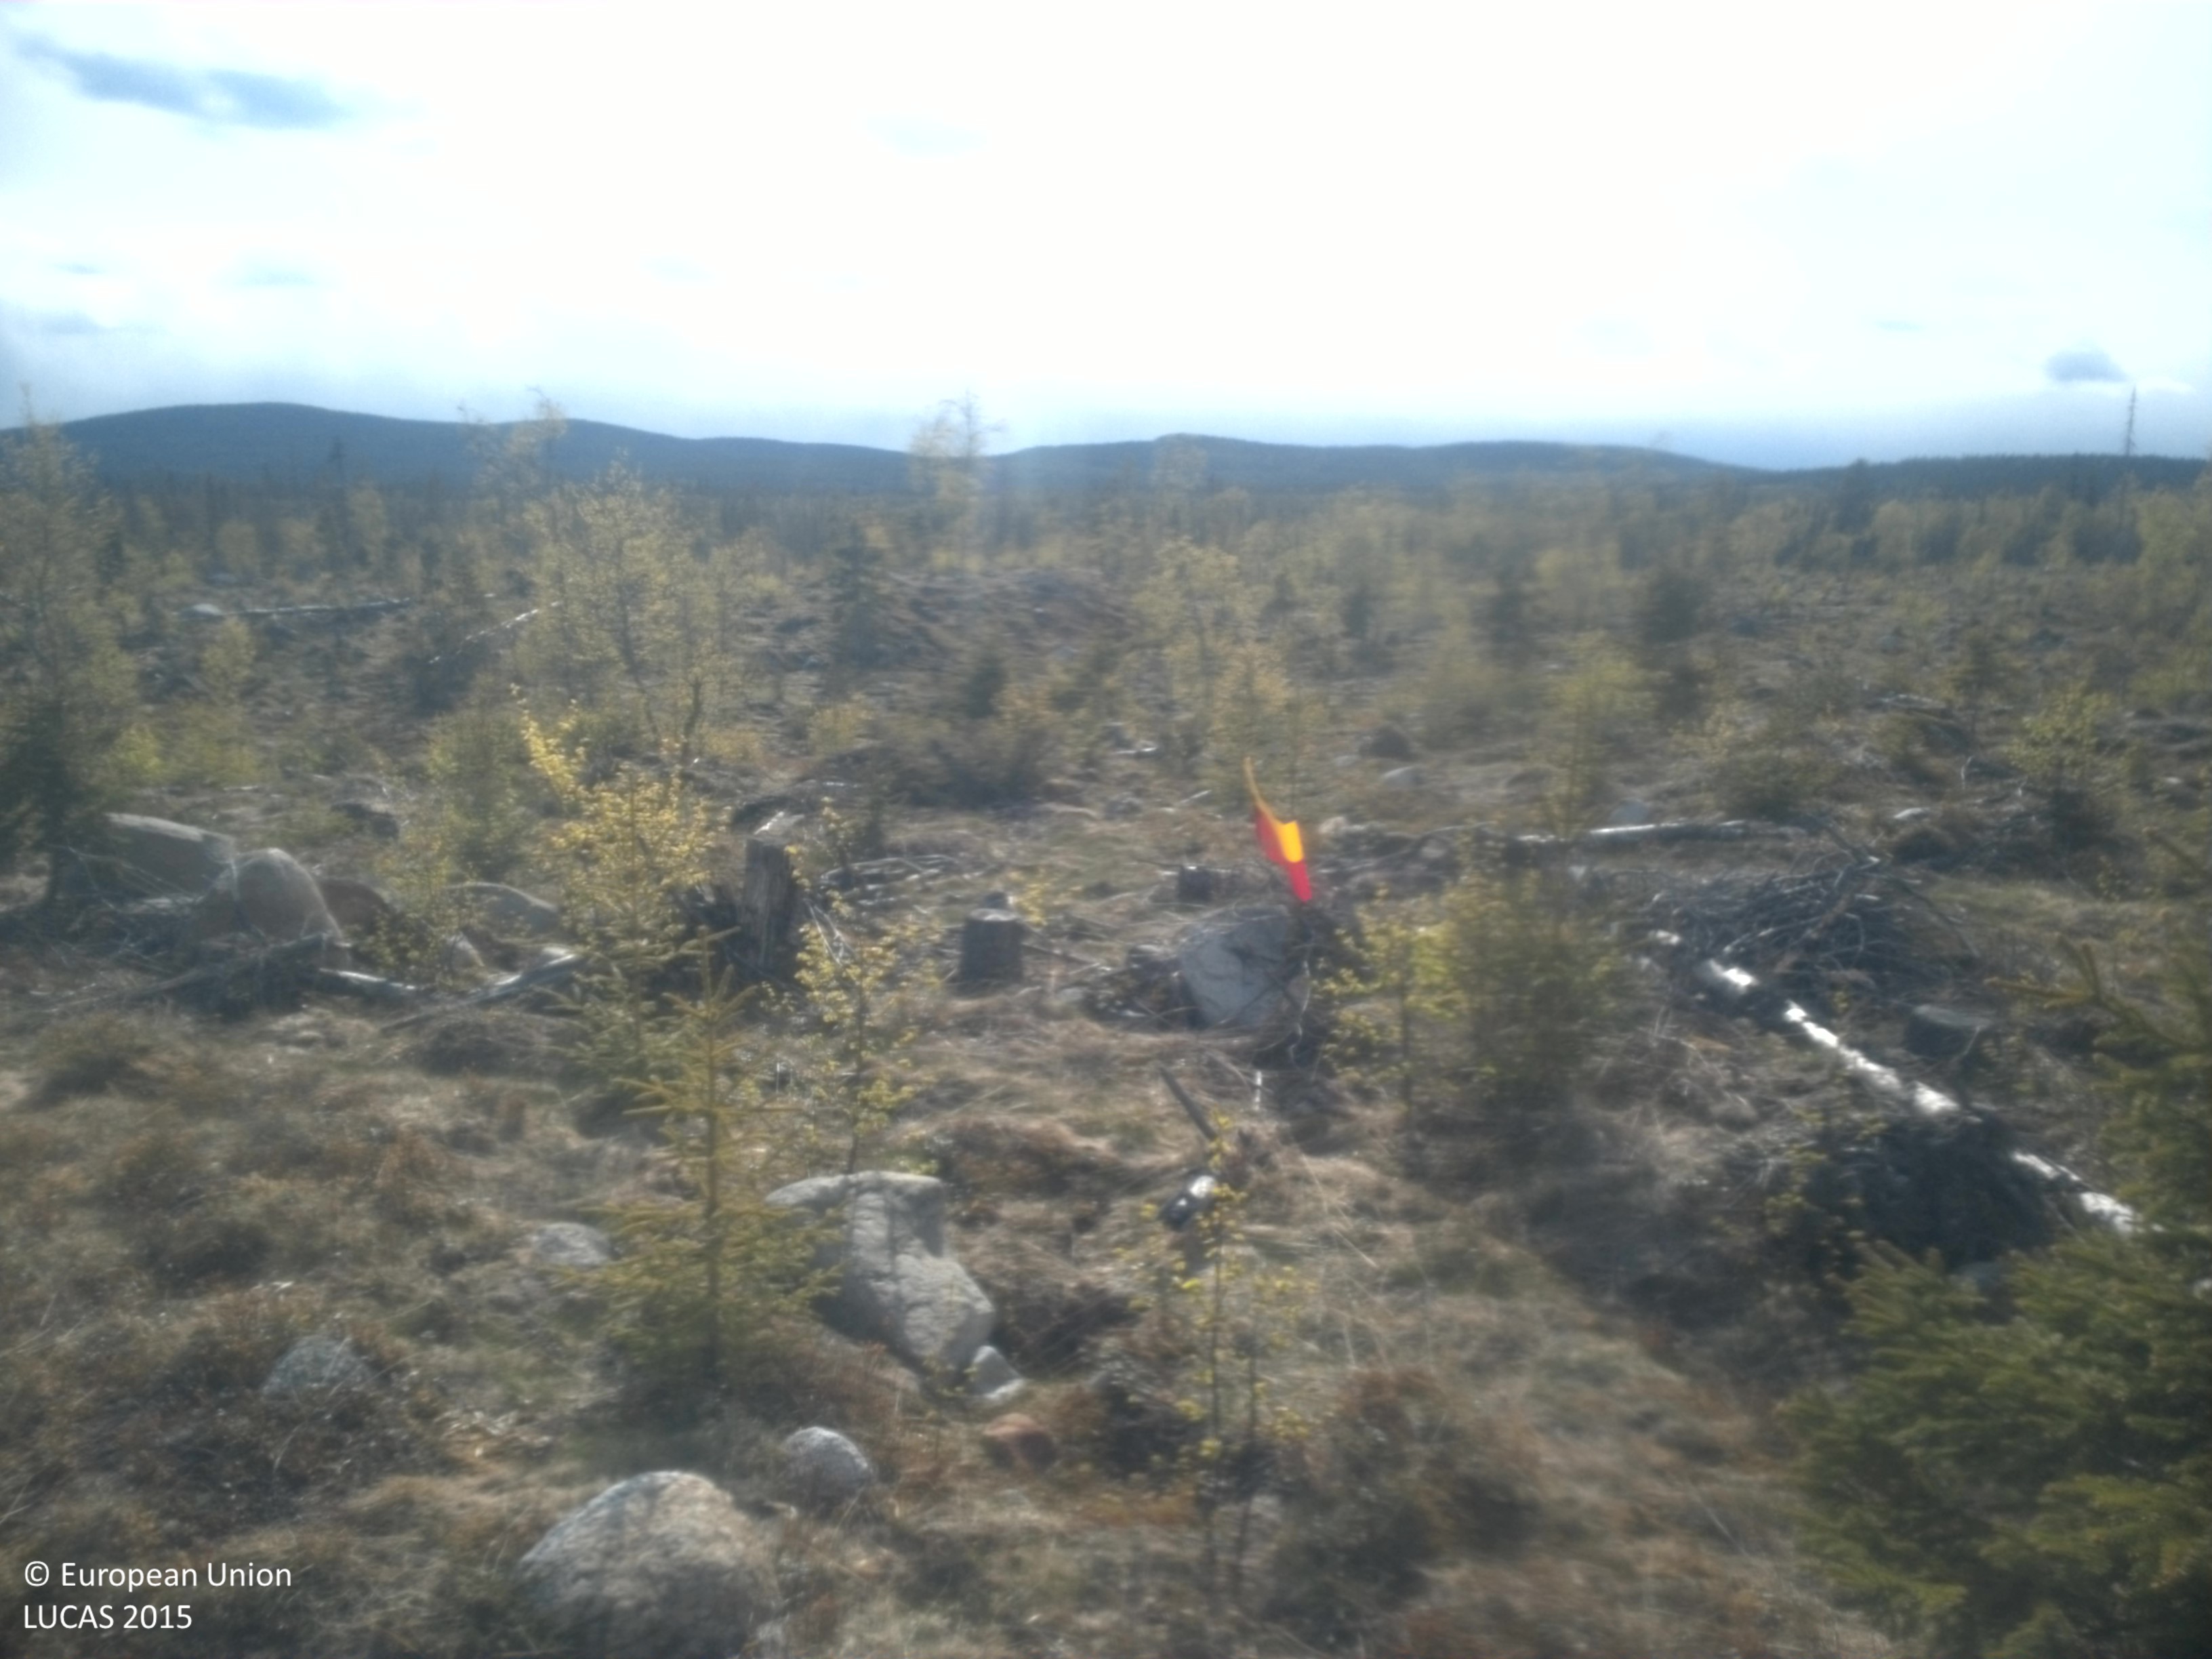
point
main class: Woodland
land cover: Spruce dominated mixed woodland
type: boreal forest
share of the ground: 10 - 25 %
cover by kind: herbaceous plants 55 %, coniferous forest trees 15 %, lichens and mosses 10 %, unconsolidated bare surface 10 %, broadleaved forest trees 5 %, shrubs 5 %
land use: Forestry
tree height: < 5 m
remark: Clear cut
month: June
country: SE
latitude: 64.4841
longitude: 17.6866
